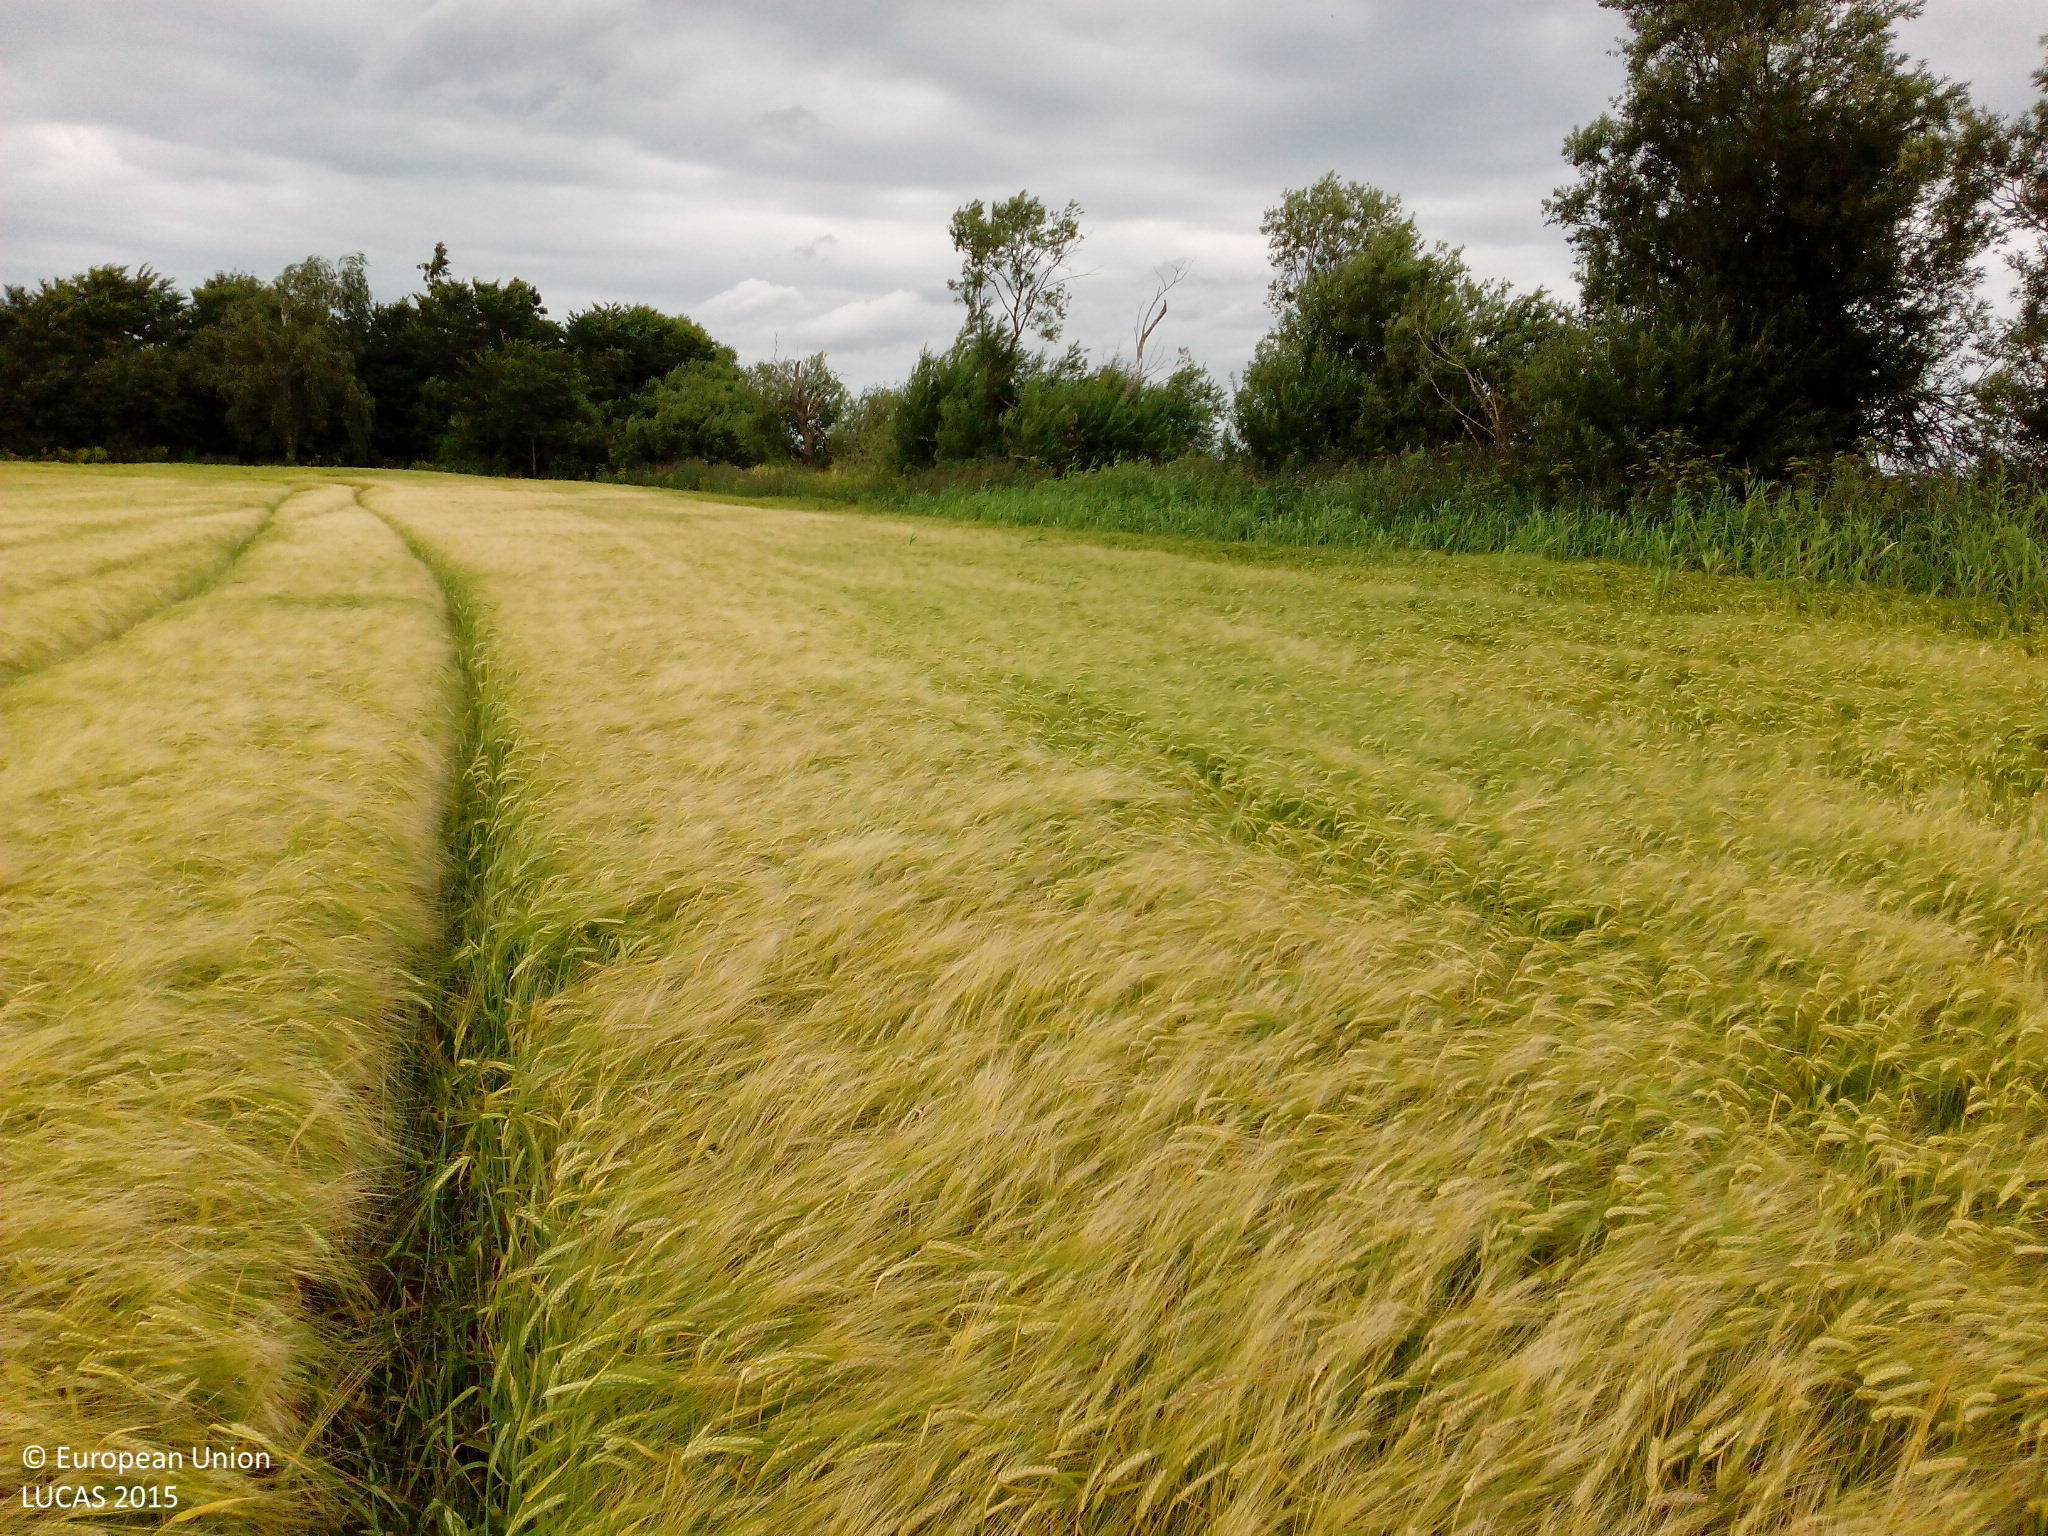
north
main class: Cropland
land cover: Barley
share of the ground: > 75 %
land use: Agriculture (excluding fallow land and kitchen gardens)
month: July
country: DK
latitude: 55.6931
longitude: 11.5417
